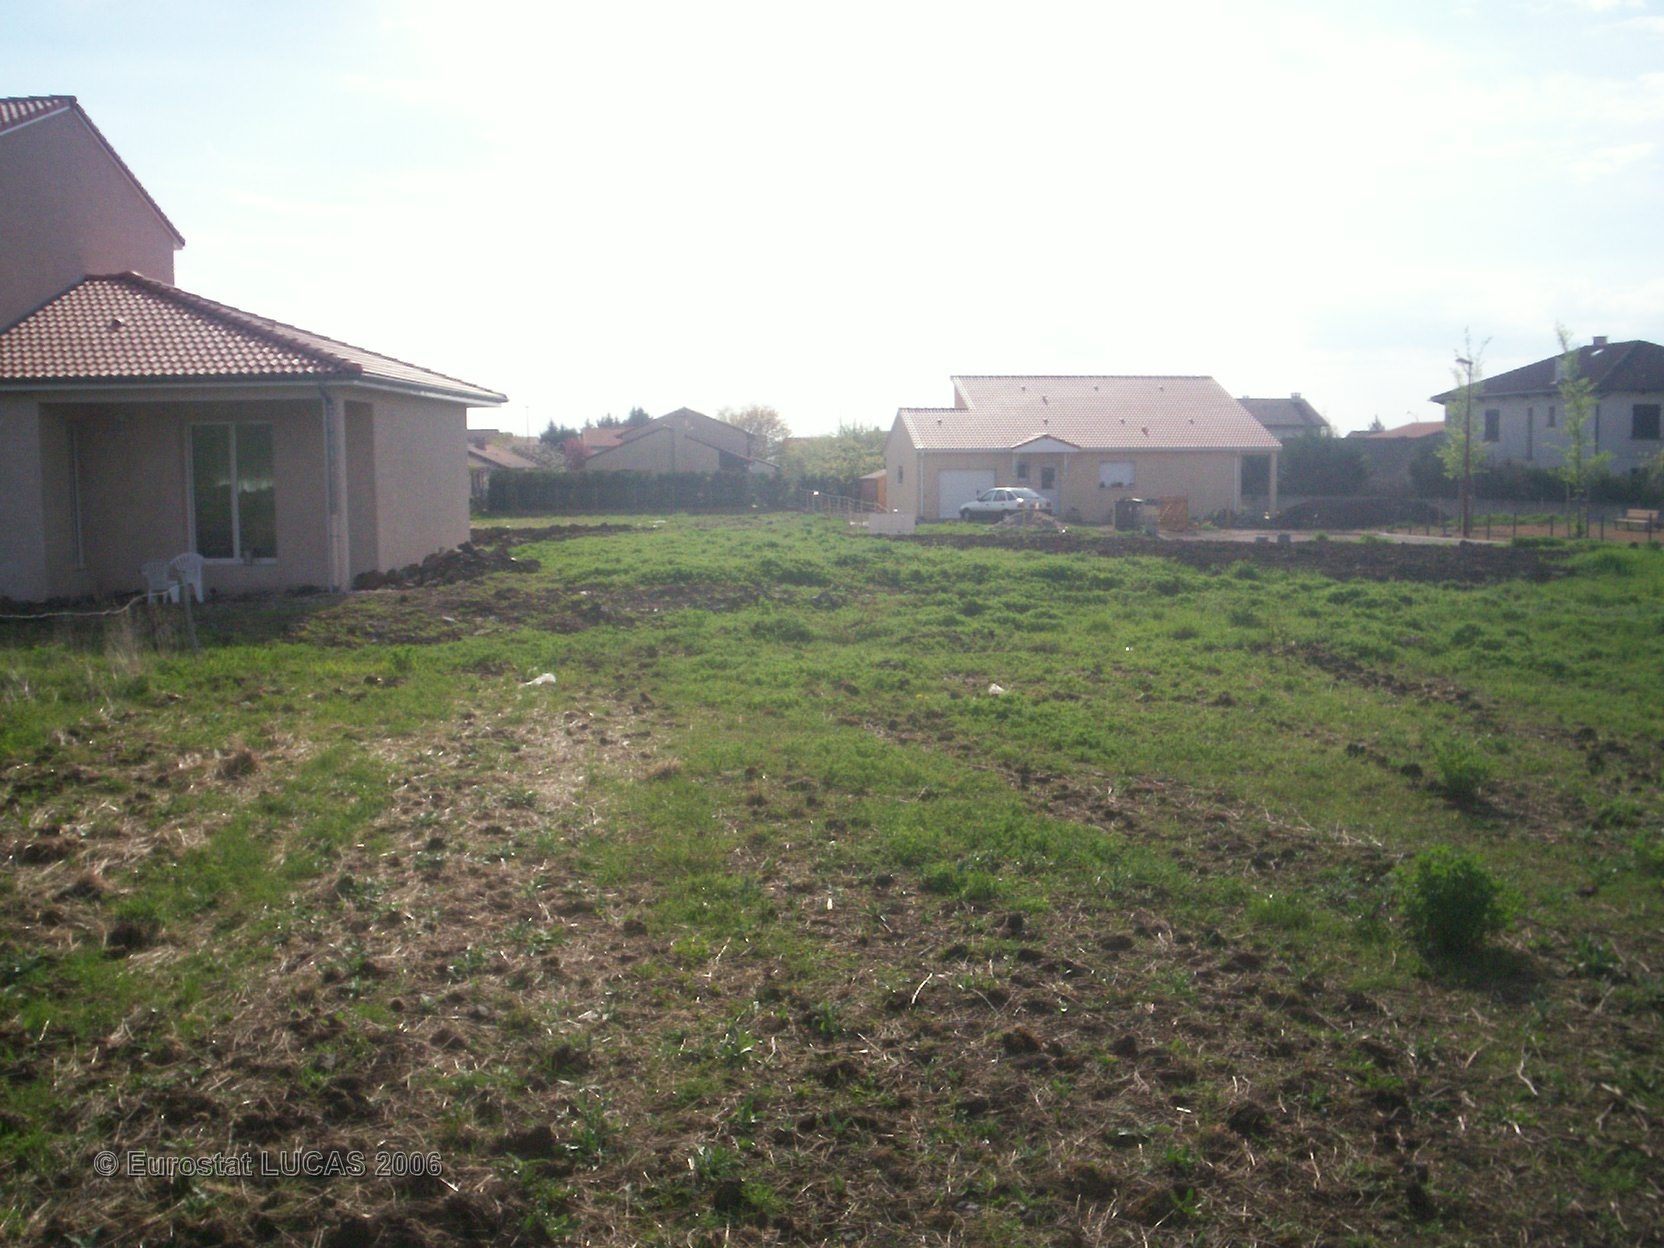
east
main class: Grassland
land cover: Grassland without tree/shrub cover
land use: Fallow land
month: April
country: FR
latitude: 45.8561
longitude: 3.0834
